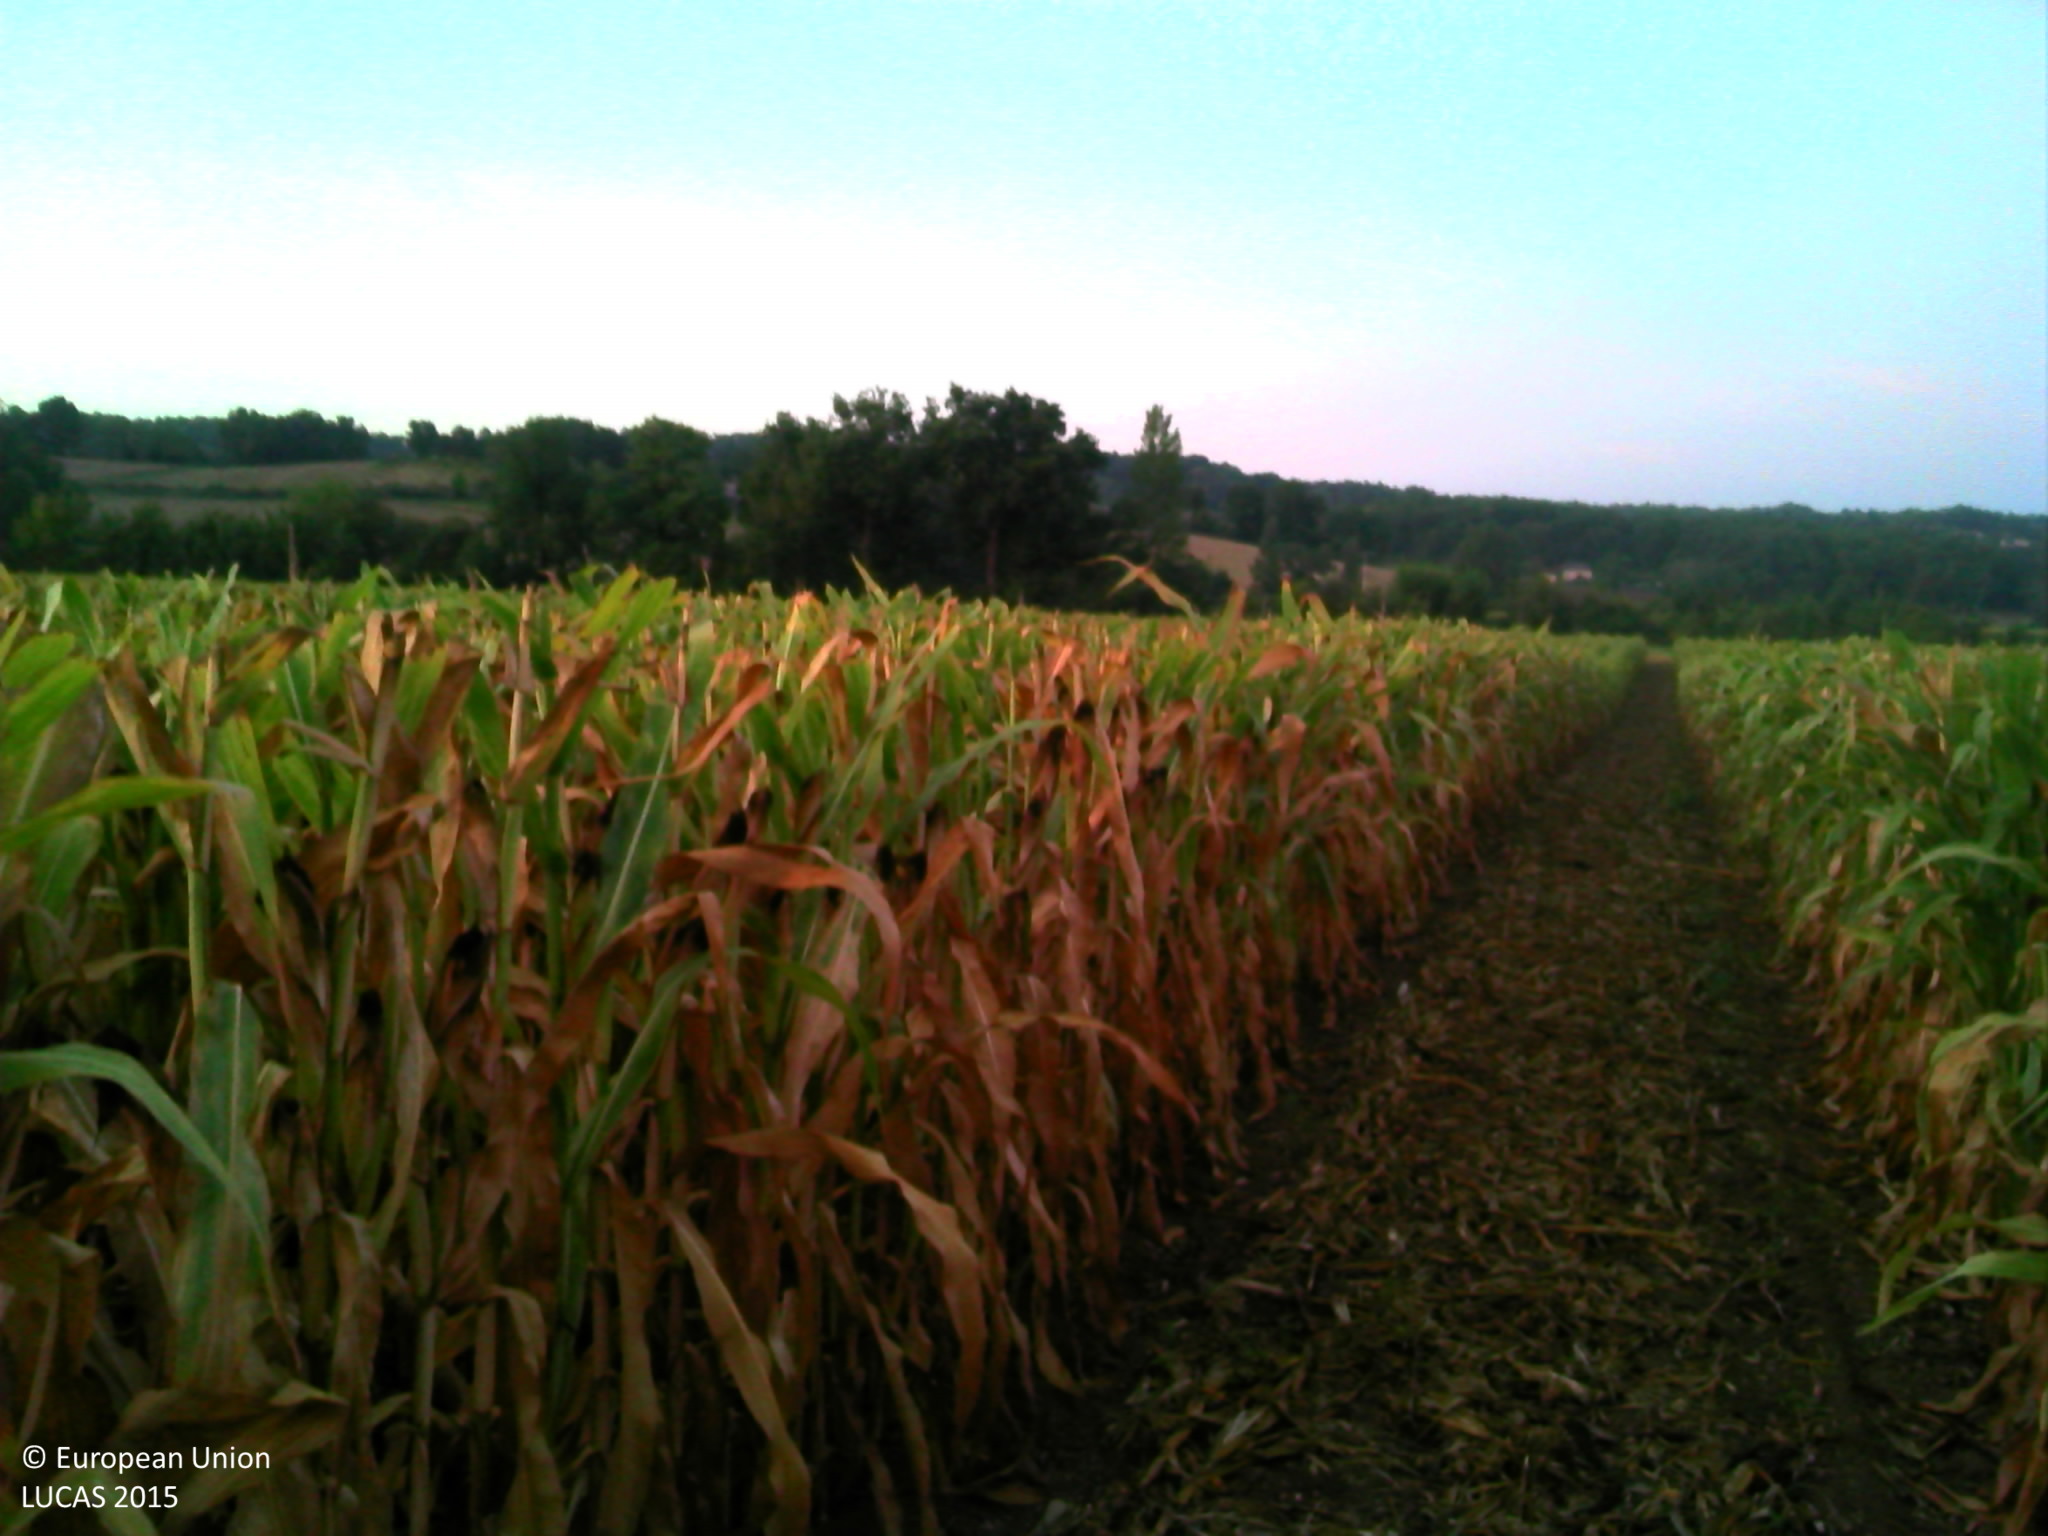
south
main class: Cropland
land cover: Maize
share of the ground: > 75 %
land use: Agriculture (excluding fallow land and kitchen gardens)
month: August
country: FR
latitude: 44.2855
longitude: 1.2135
